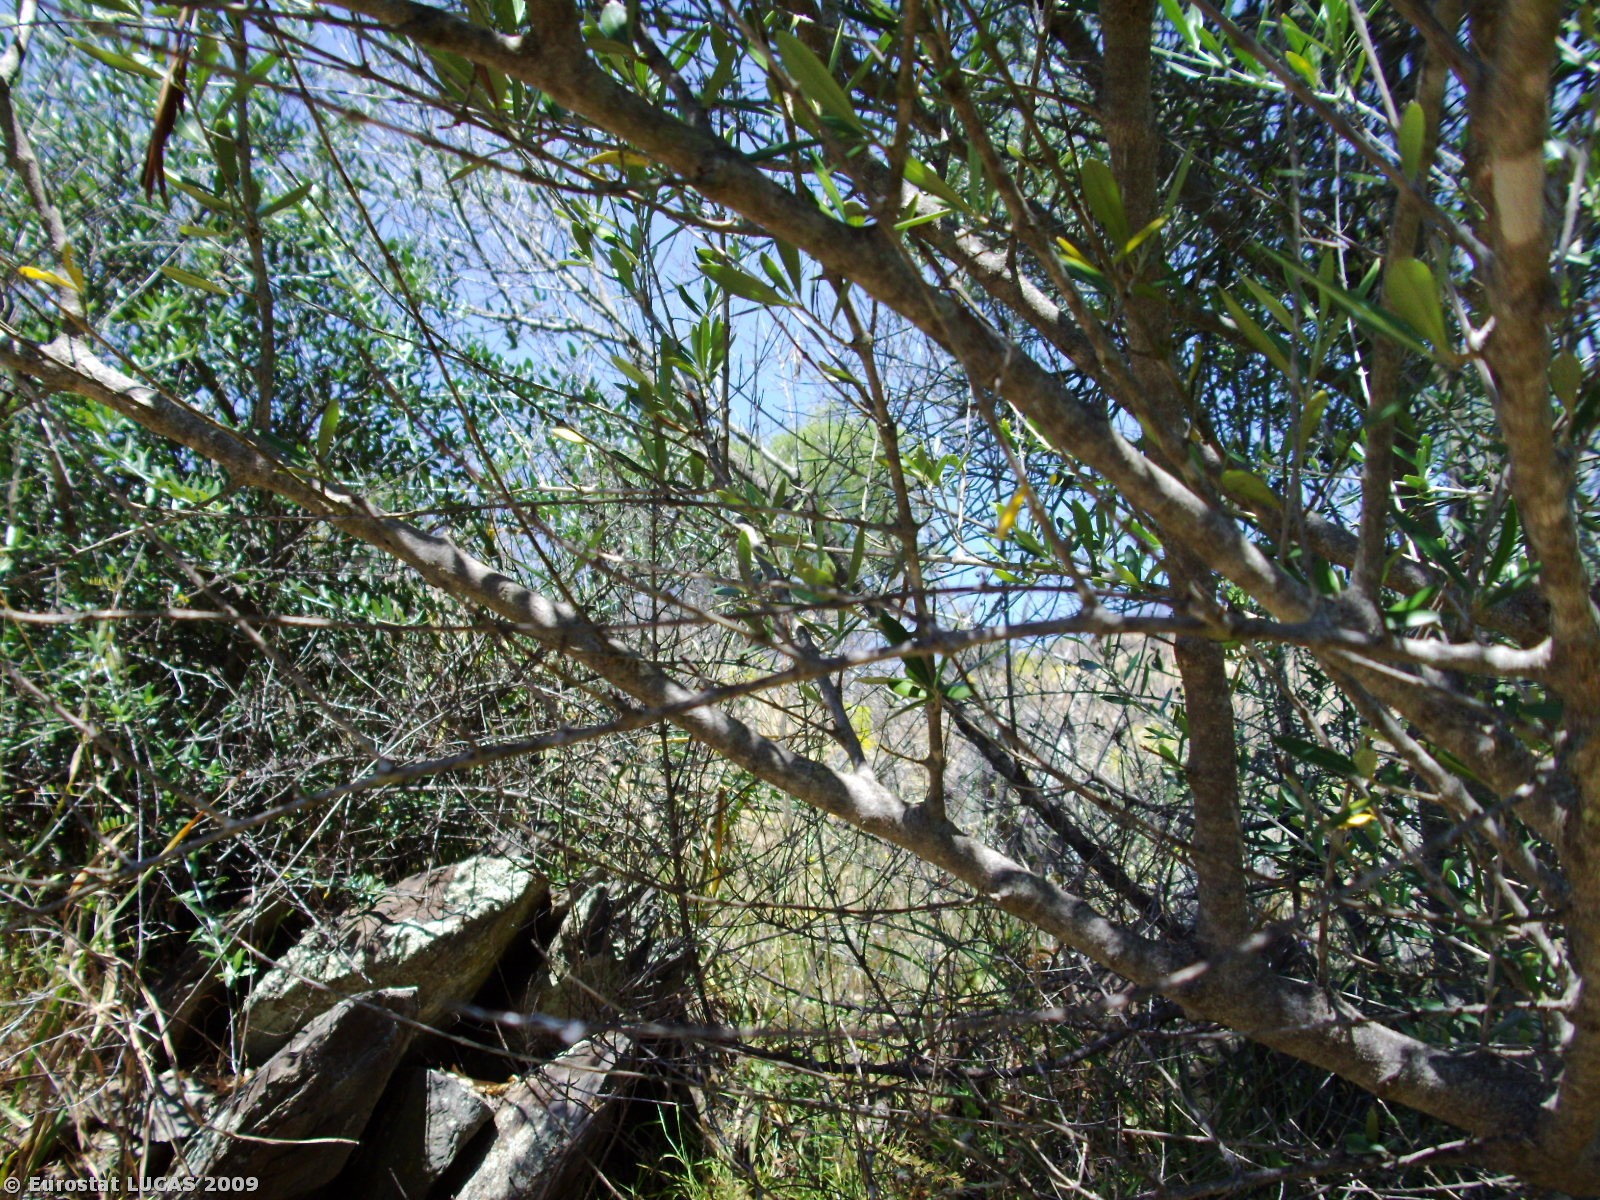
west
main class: Cropland
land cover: Olive groves
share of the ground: 25 - 50 %
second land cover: Spontaneously vegetated surfaces
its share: > 75 %
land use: Fallow land
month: May
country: PT
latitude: 37.5155
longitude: -7.6049
